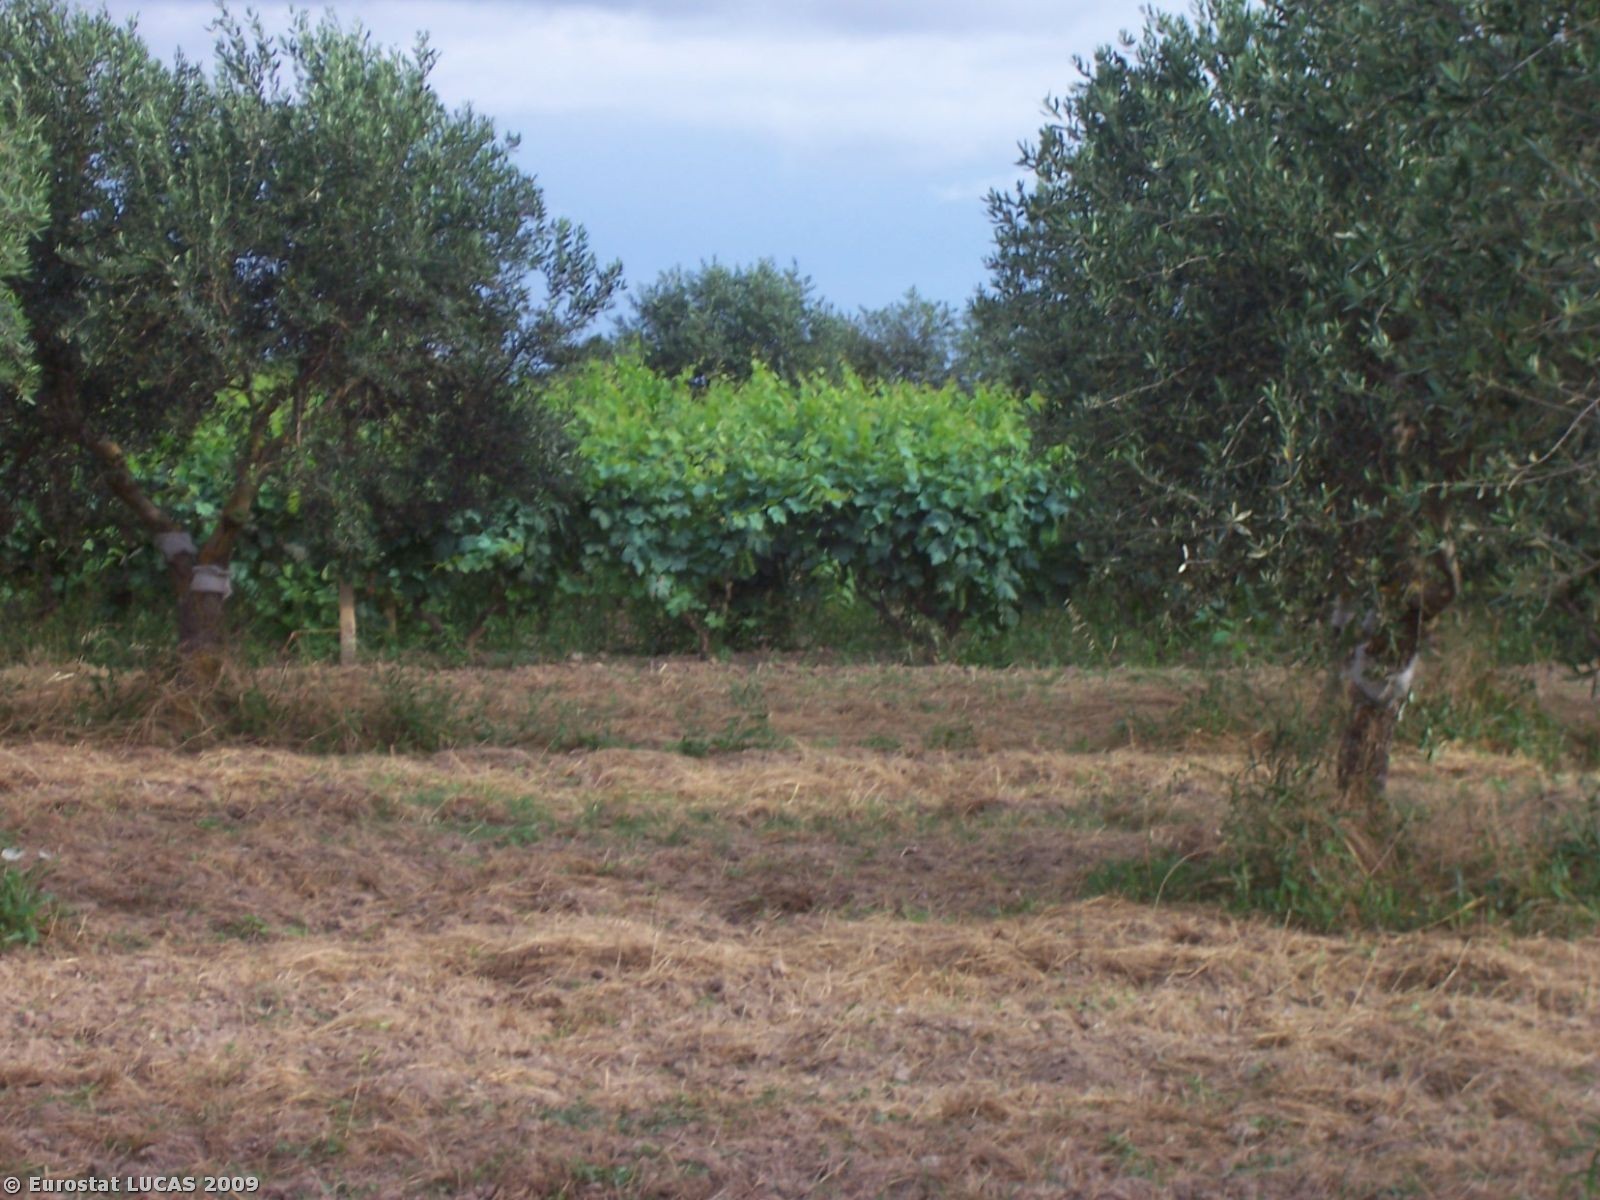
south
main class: Cropland
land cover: Nuts trees
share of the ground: 50 - 75 %
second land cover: Bare land
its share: > 75 %
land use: Agriculture (excluding fallow land and kitchen gardens)
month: June
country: IT
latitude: 40.4335
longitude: 17.5080
